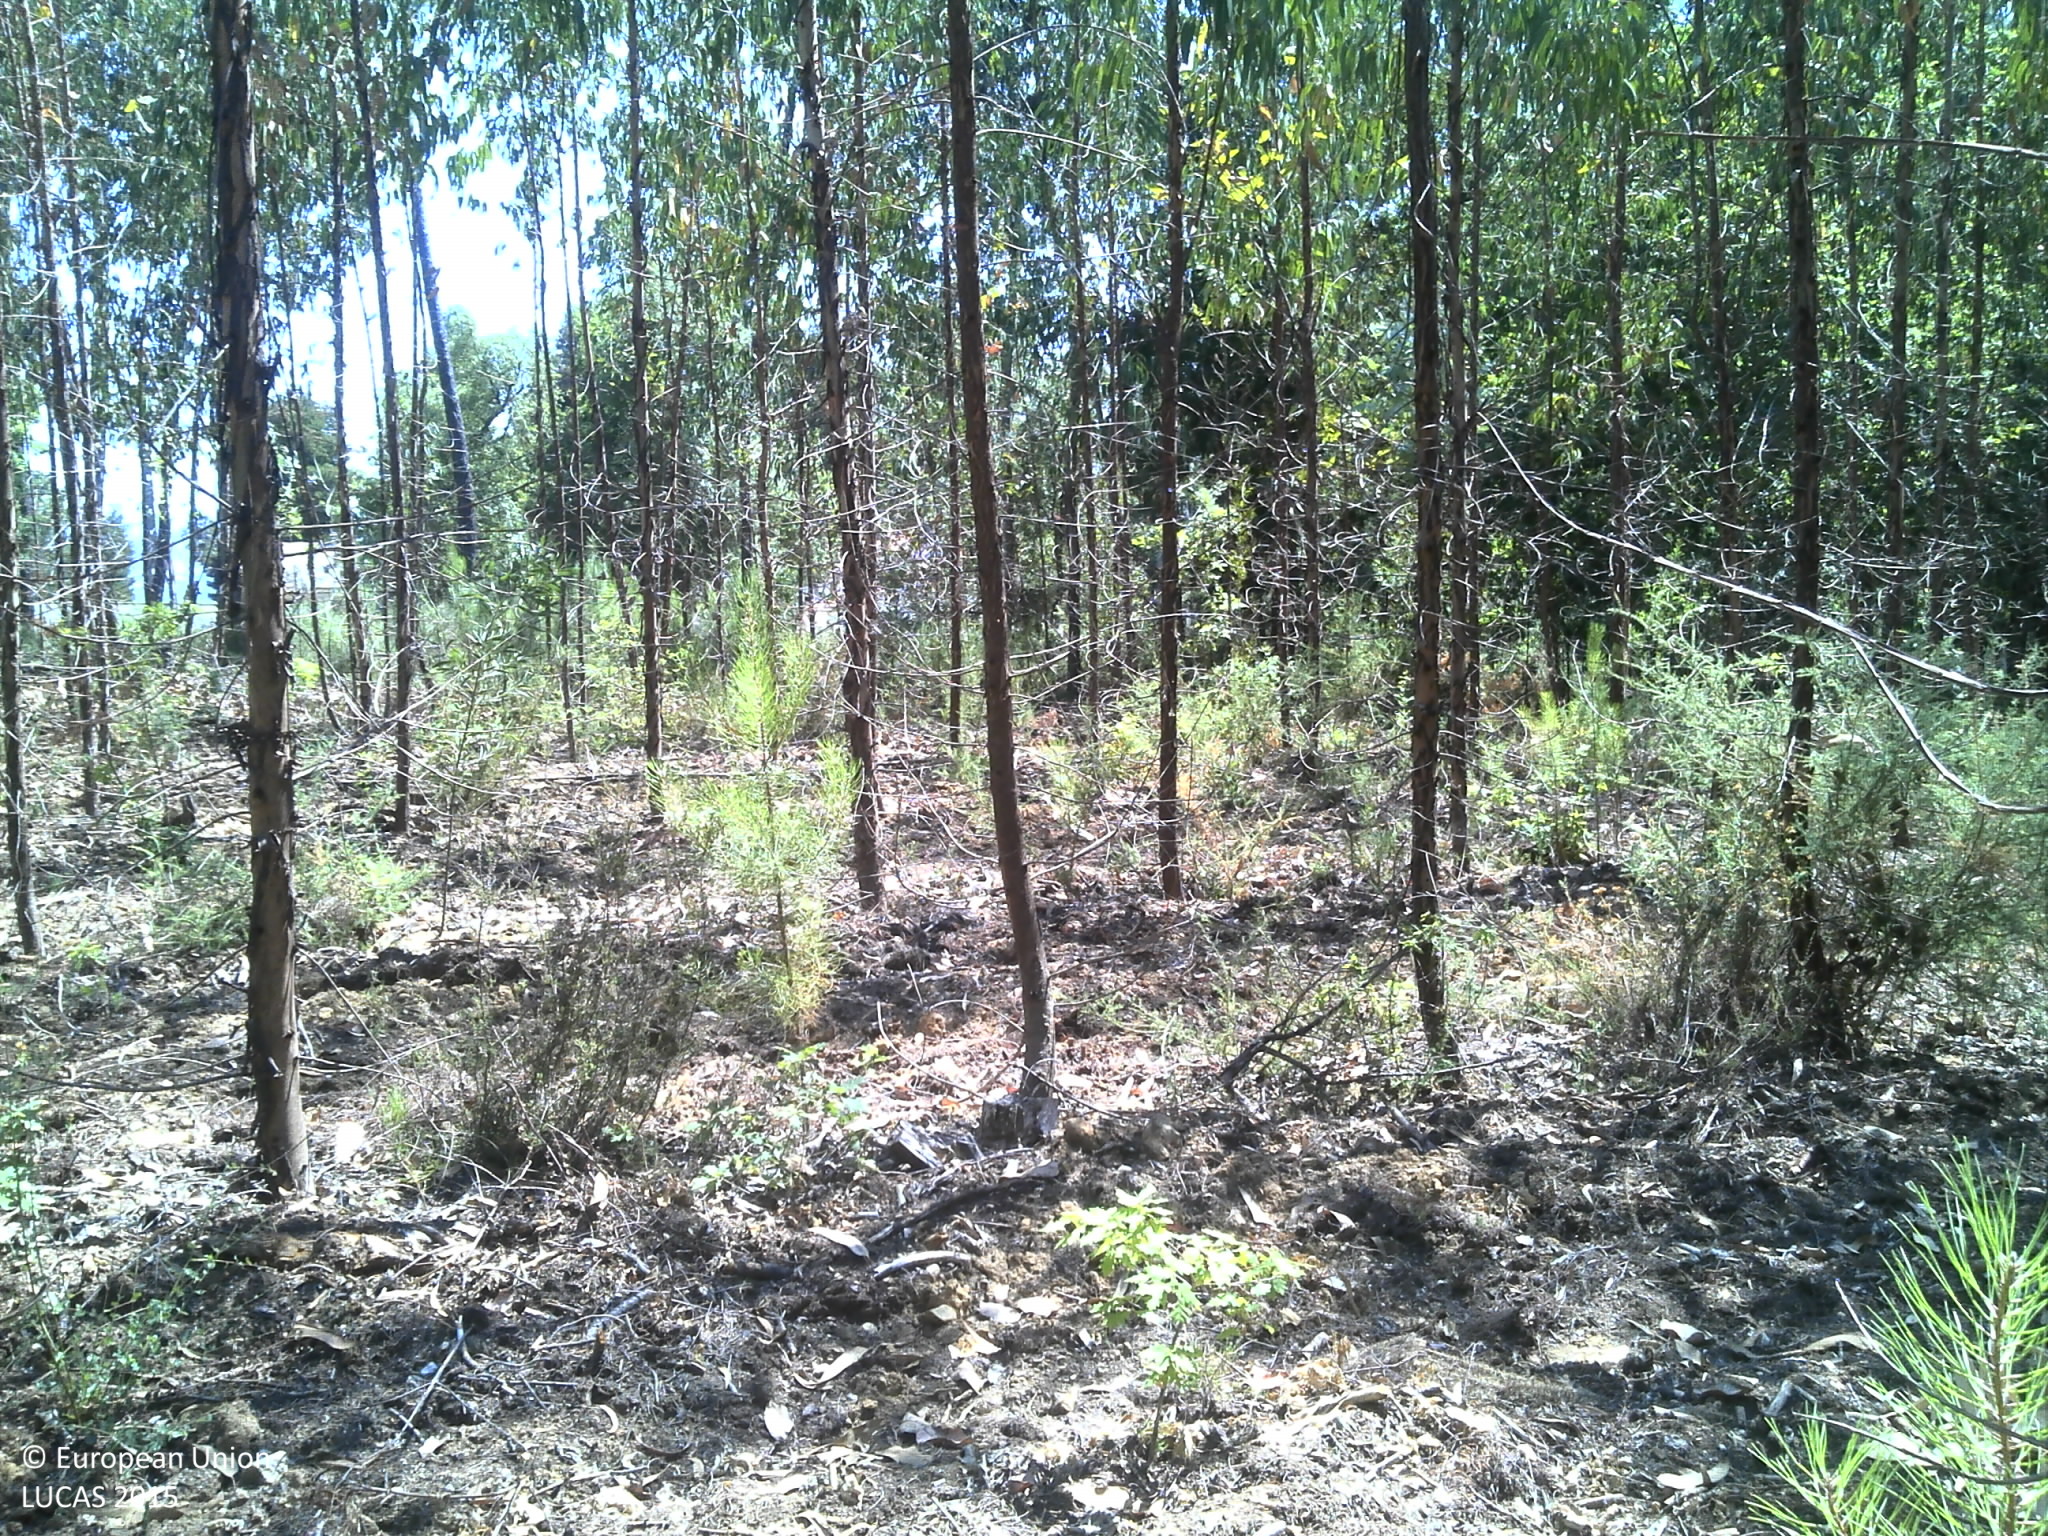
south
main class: Woodland
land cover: Broadleaved woodland
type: exotic forest
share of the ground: 25 - 50 %
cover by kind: broadleaved forest trees 50 %, unconsolidated bare surface 35 %, shrubs 15 %
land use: Forestry
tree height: > 5 m
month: July
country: PT
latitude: 40.3067
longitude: -7.9931
